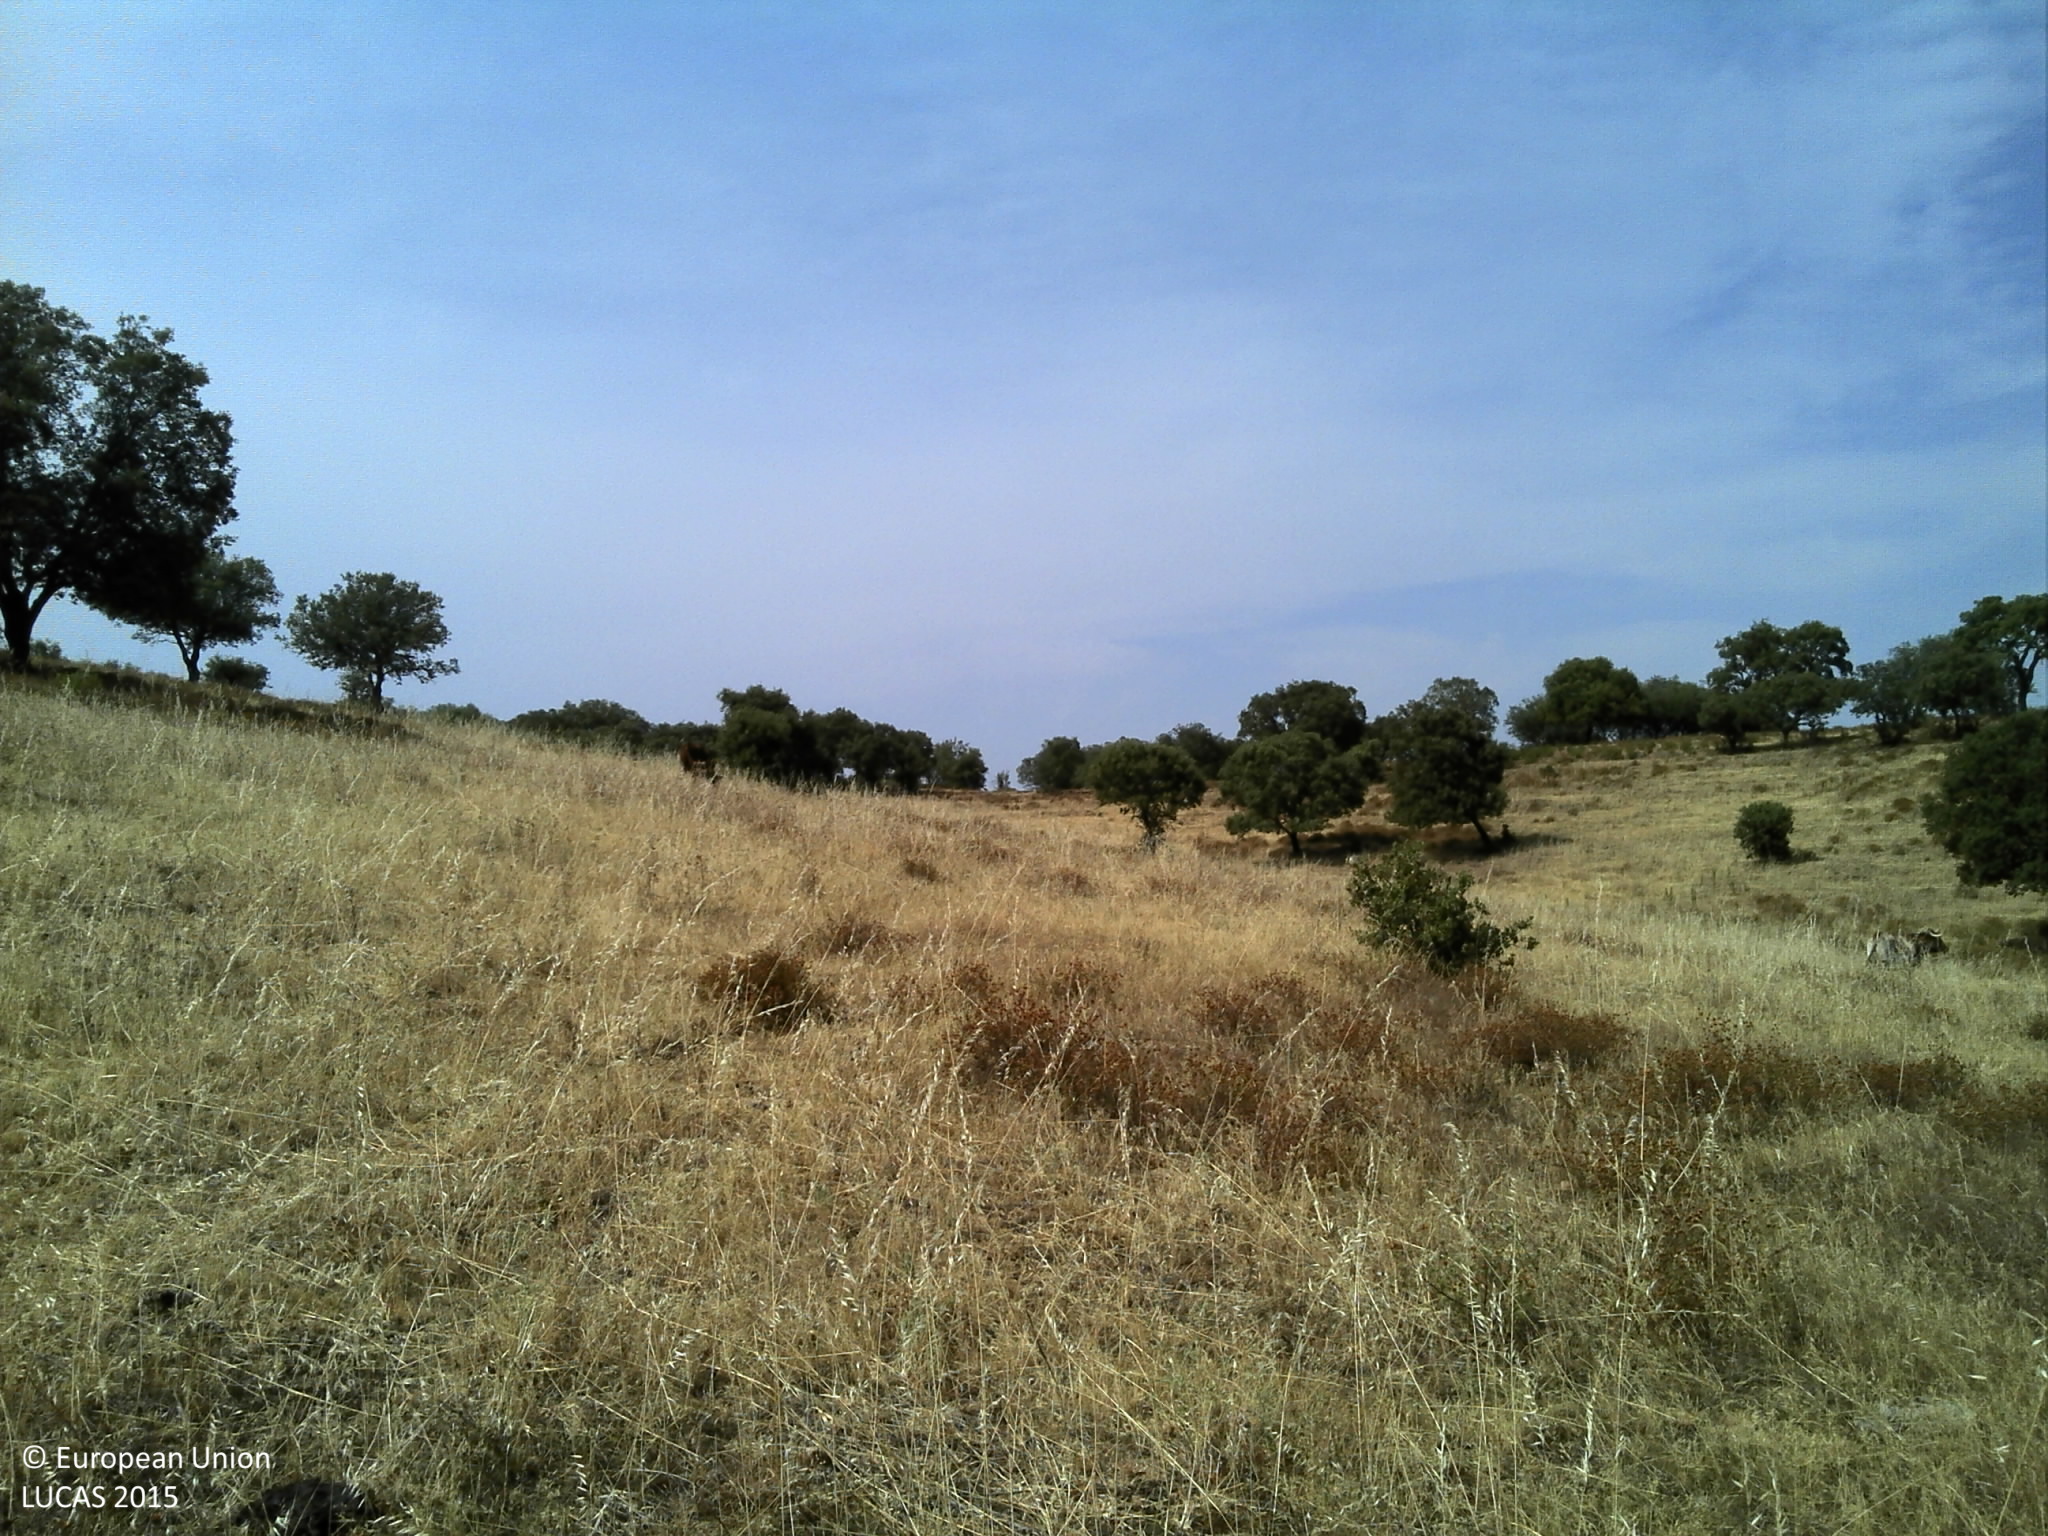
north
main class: Grassland
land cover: Grassland with sparse tree/shrub cover
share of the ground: > 75 %
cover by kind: herbaceous plants 80 %, unconsolidated bare surface 15 %, broadleaved forest trees 5 %
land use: Agriculture (excluding fallow land and kitchen gardens)
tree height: > 5 m
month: June
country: PT
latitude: 38.6620
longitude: -7.6997
